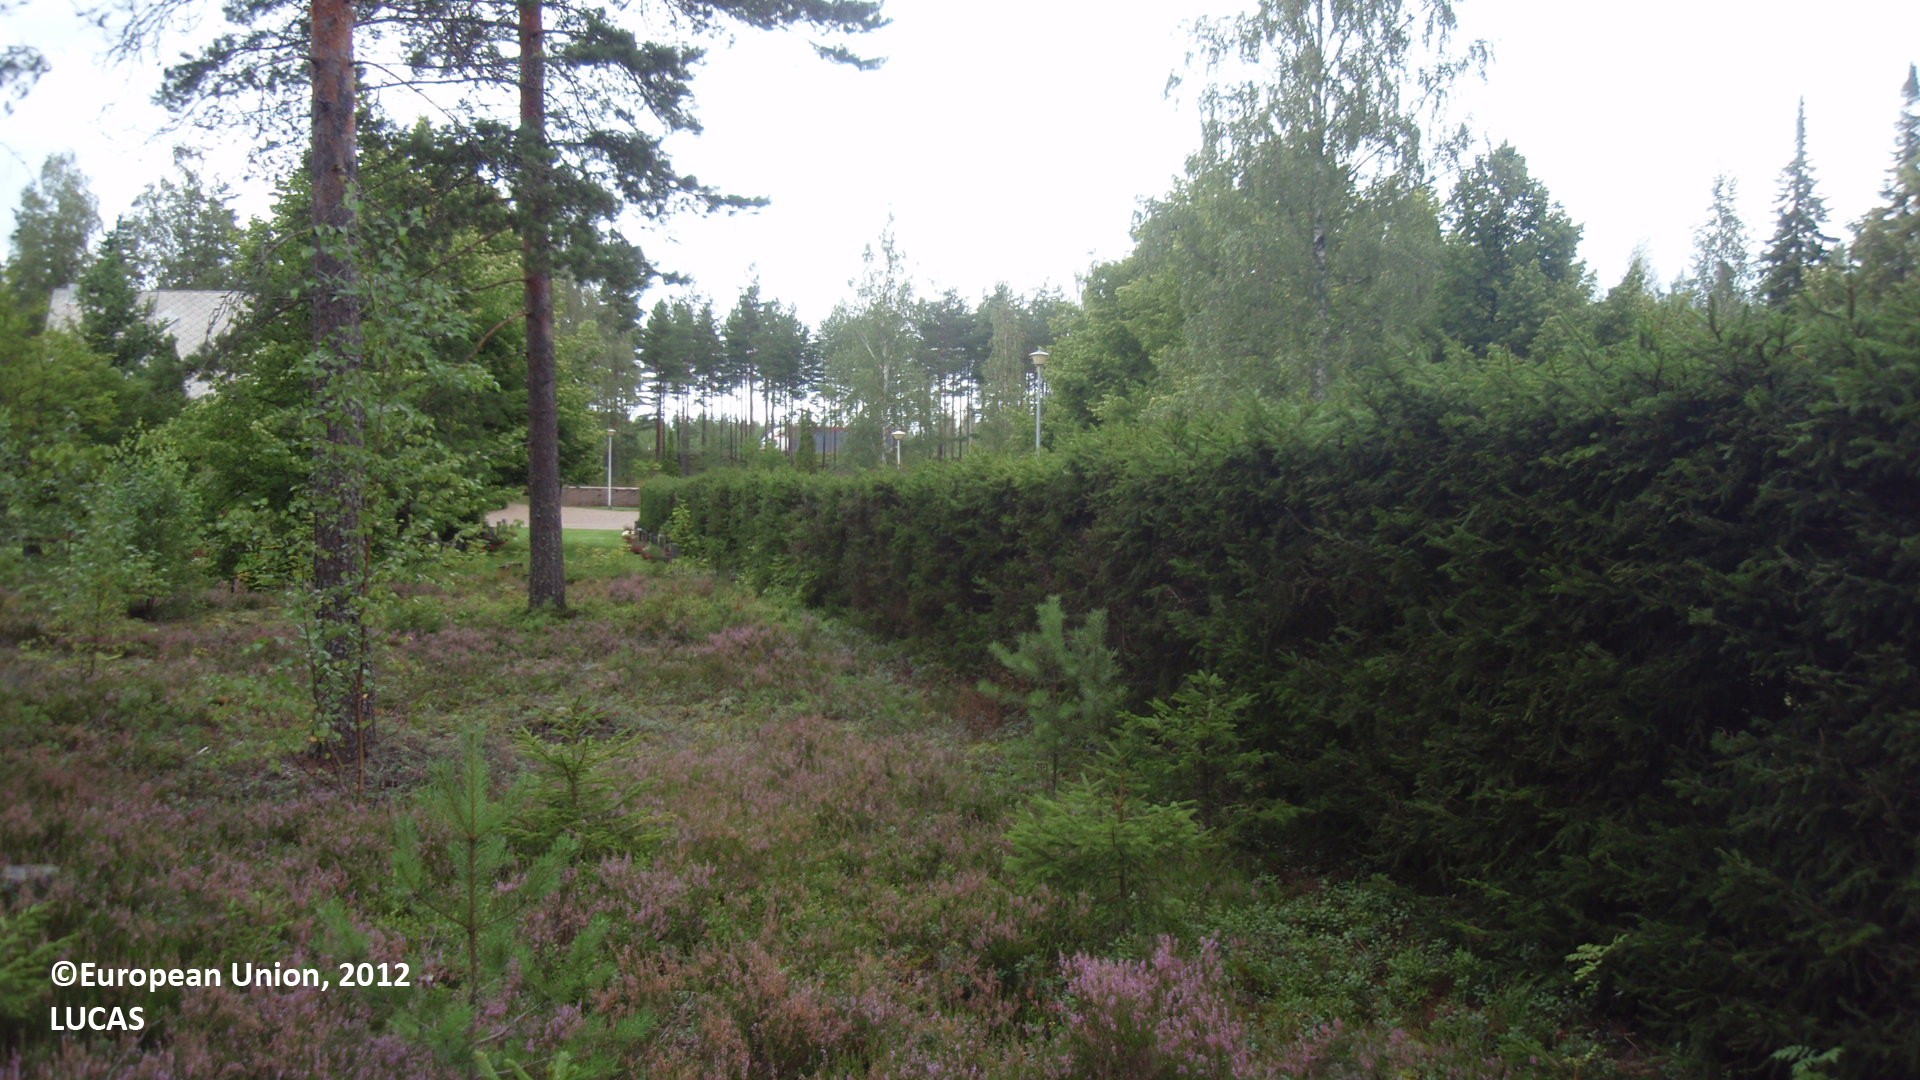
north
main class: Woodland
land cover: Pine dominated mixed woodland
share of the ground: 25 - 50 %
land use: Community services
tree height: > 5 m
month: August
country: FI
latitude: 60.9199
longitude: 27.5405
